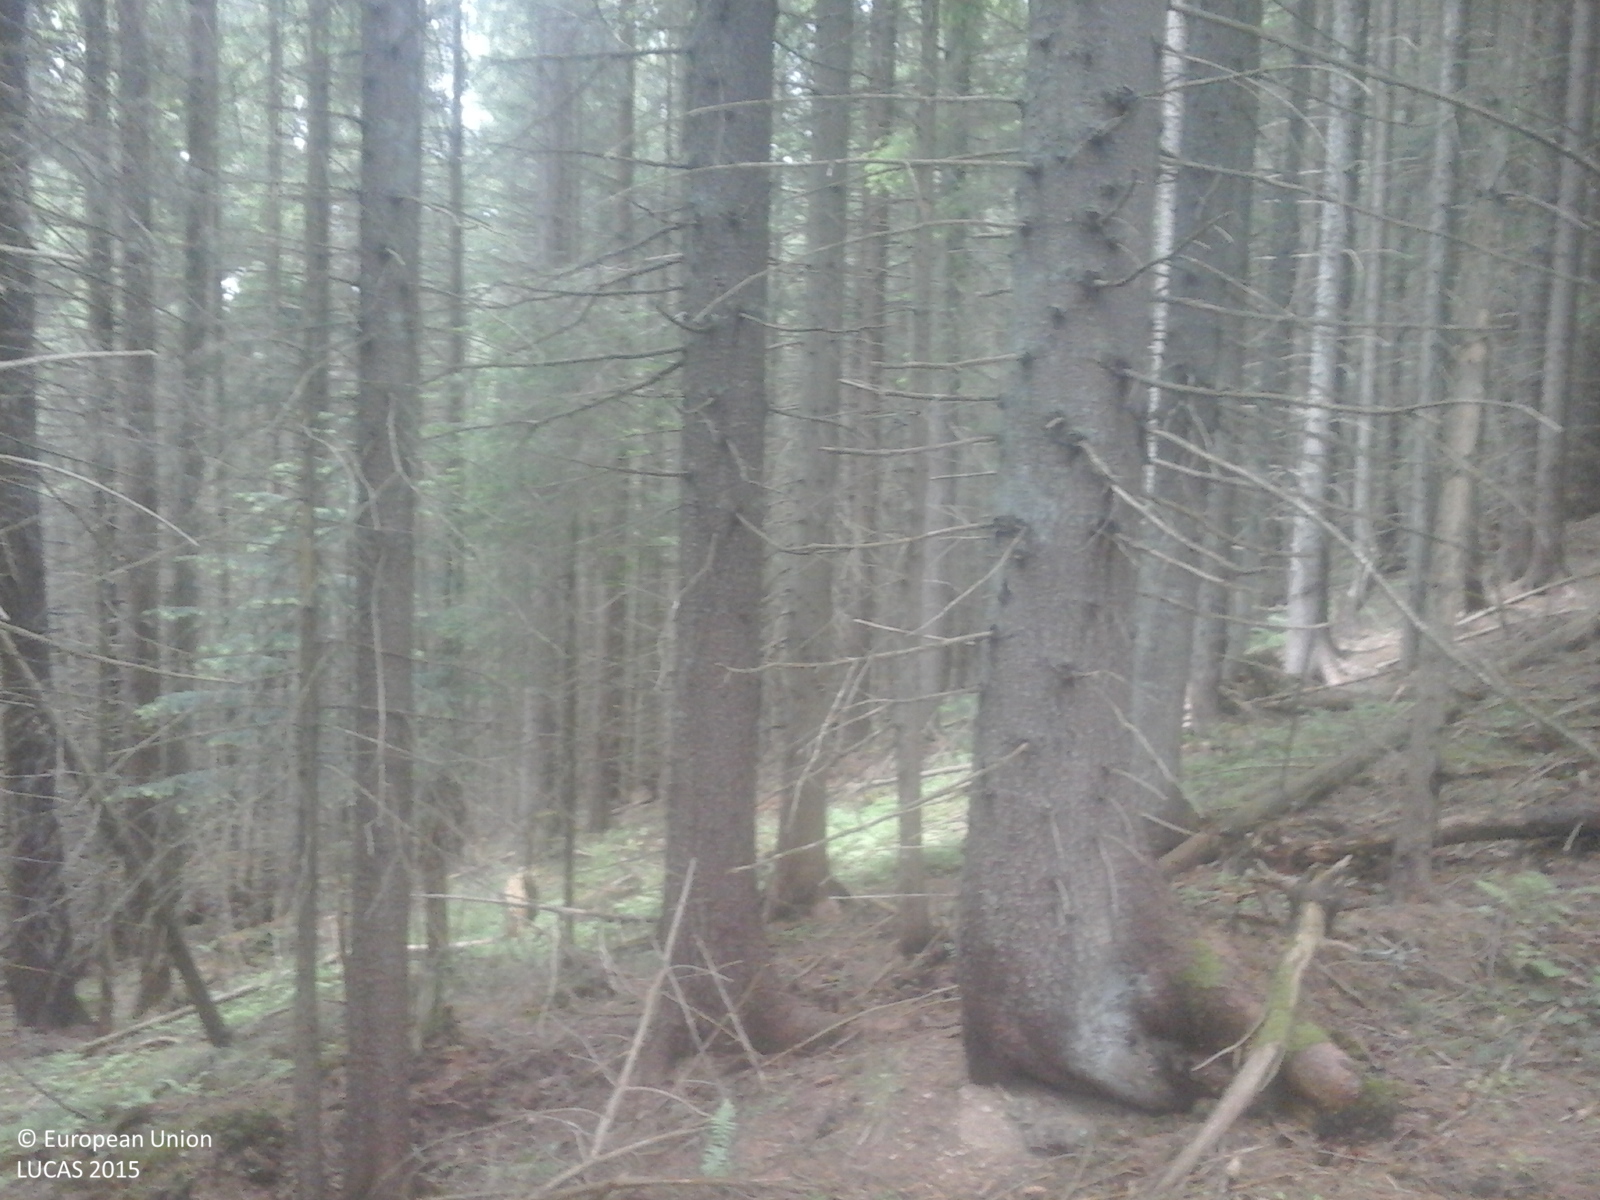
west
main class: Woodland
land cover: Spruce dominated coniferous woodland
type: alpine coniferous forest
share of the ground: > 75 %
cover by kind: coniferous forest trees 90 %, broadleaved forest trees 10 %
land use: Forestry
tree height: > 5 m
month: June
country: RO
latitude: 47.4281
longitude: 25.1272
